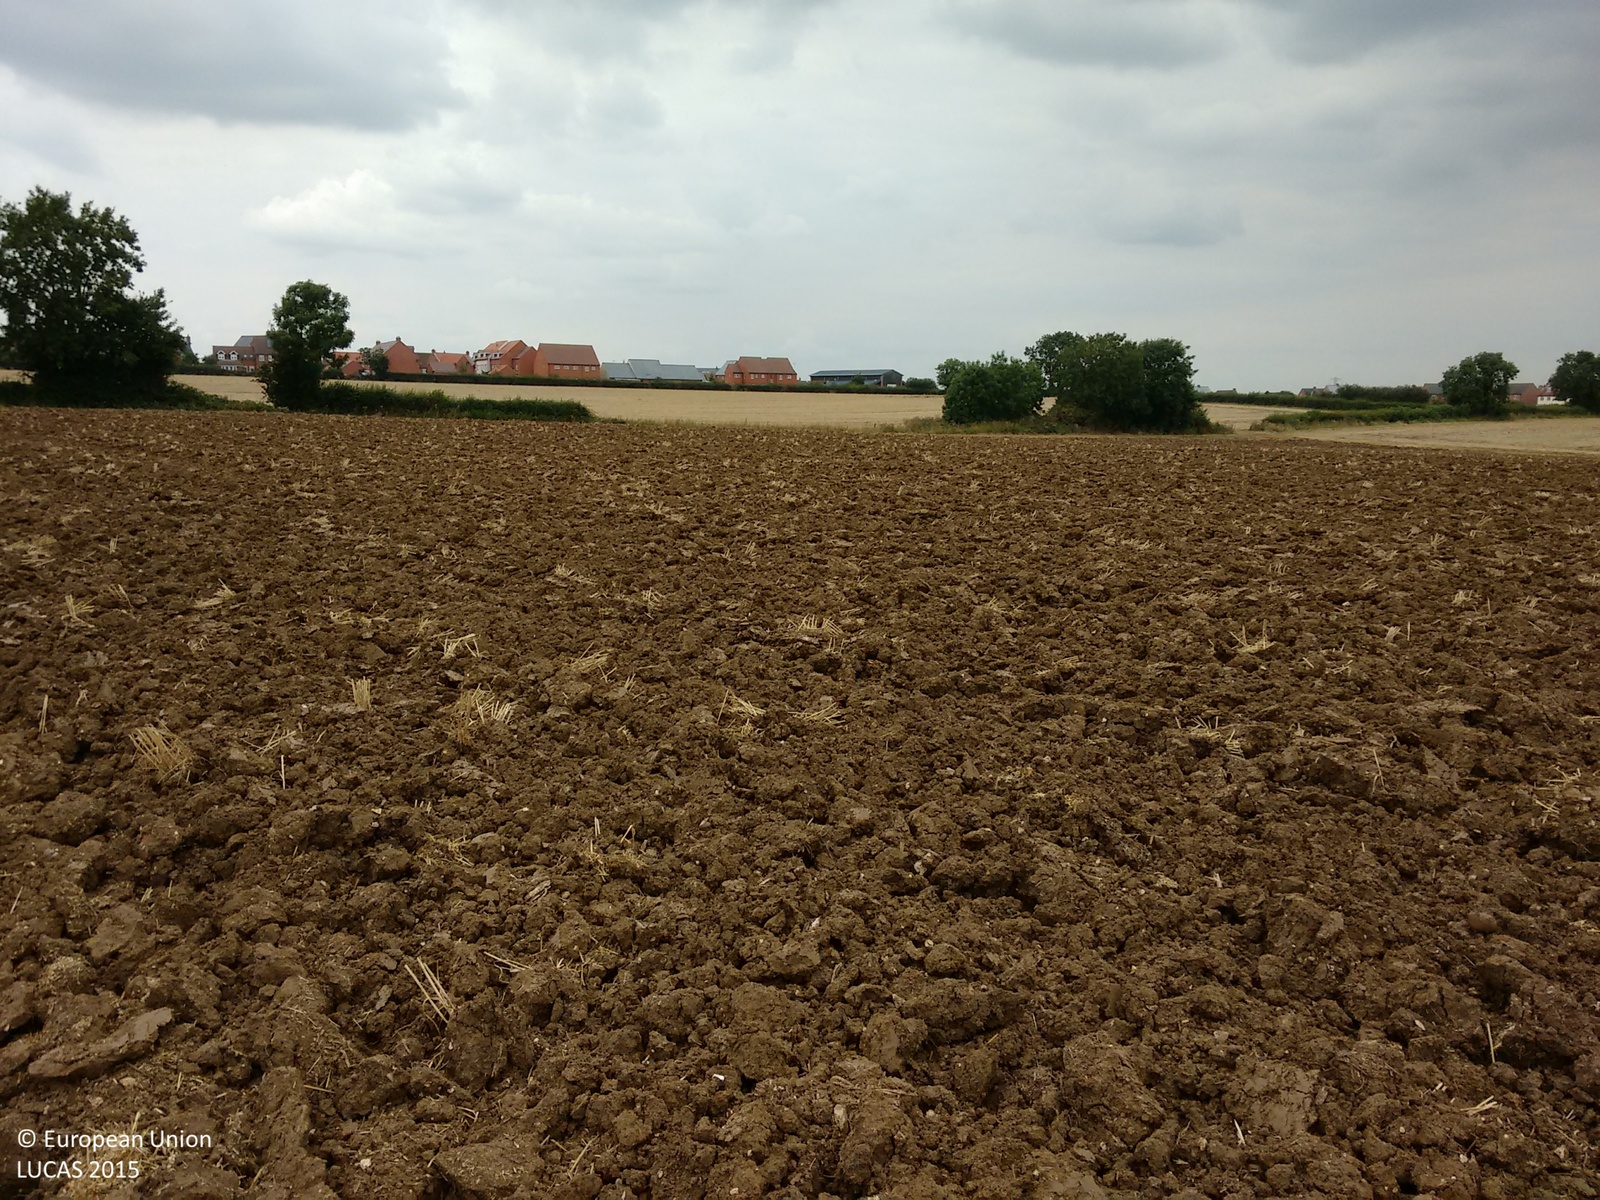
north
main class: Cropland
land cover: Common wheat
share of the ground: < 10 %
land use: Agriculture (excluding fallow land and kitchen gardens)
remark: Harvested field
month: August
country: GB
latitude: 52.3723
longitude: -0.8083
